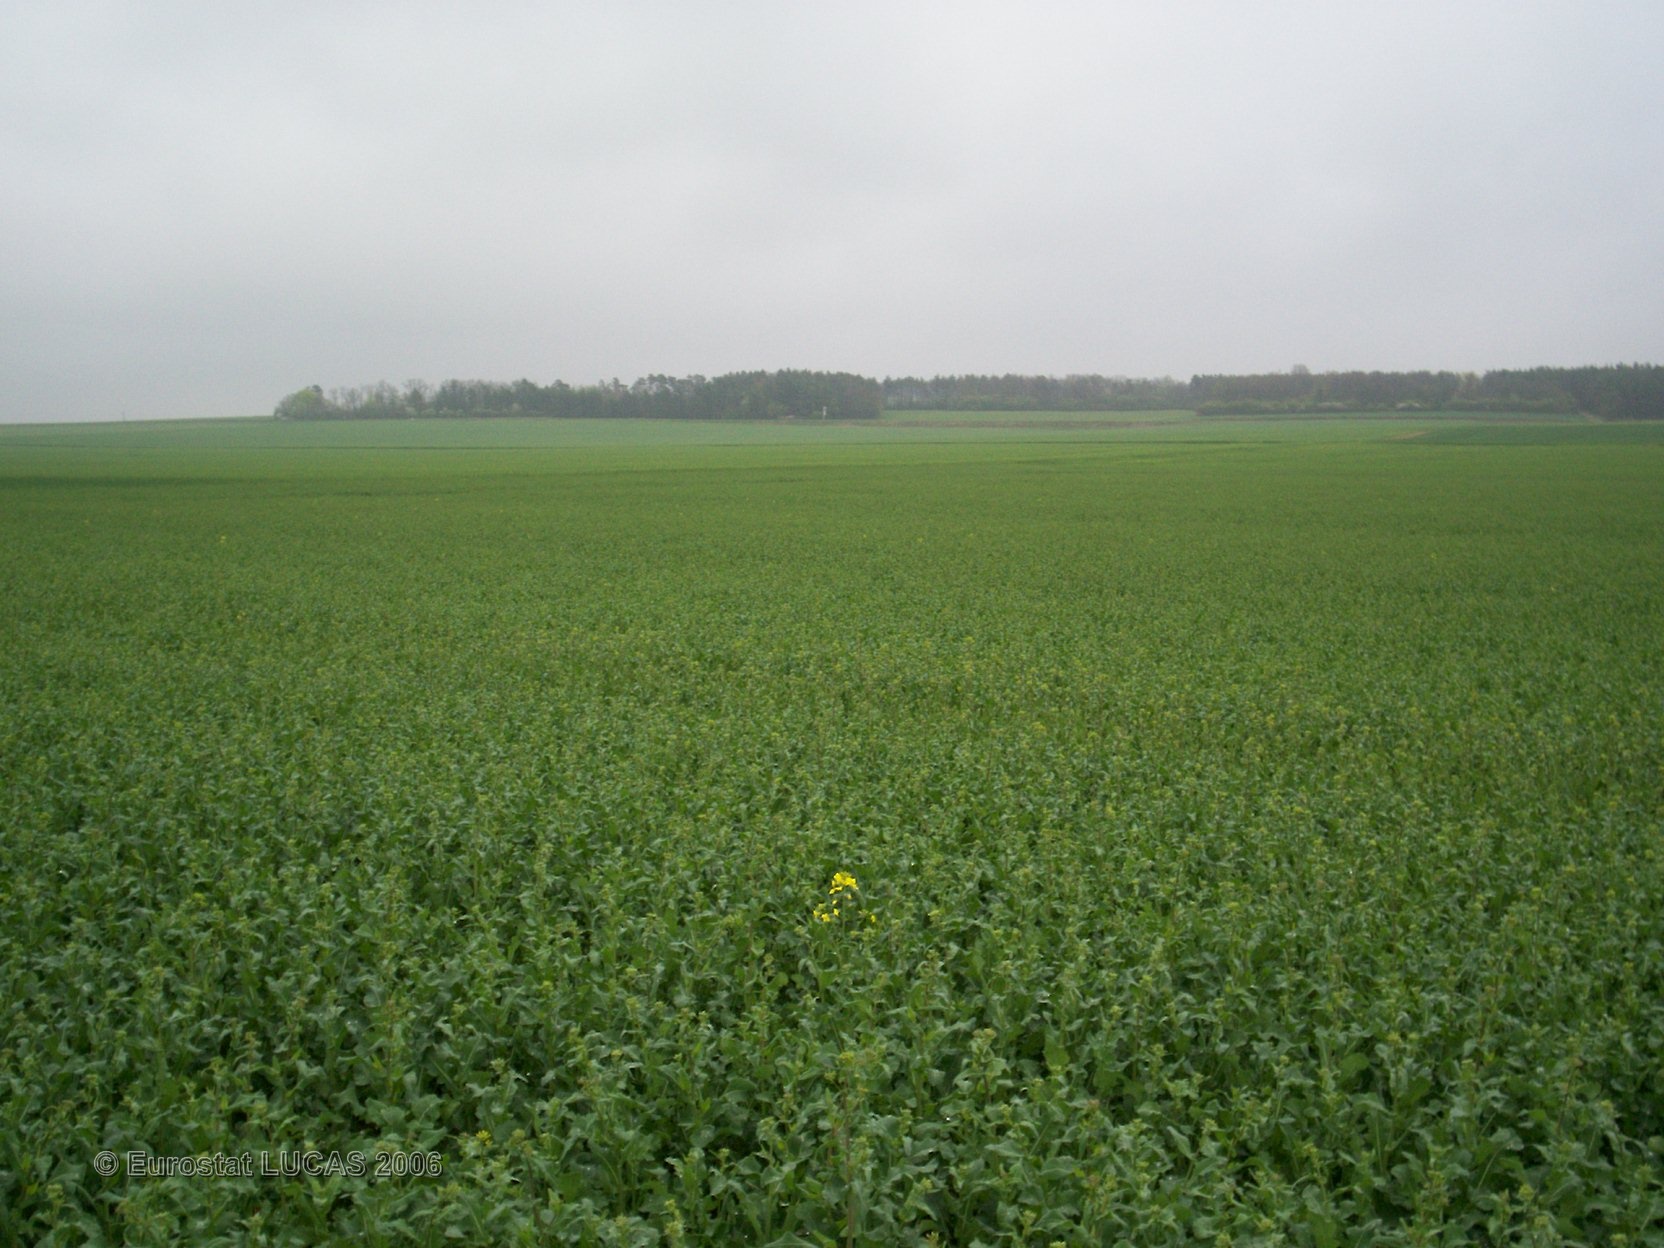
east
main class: Cropland
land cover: Rape and turnip rape
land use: Agriculture (excluding fallow land and kitchen gardens)
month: April
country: FR
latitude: 47.7983
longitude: 4.5113
